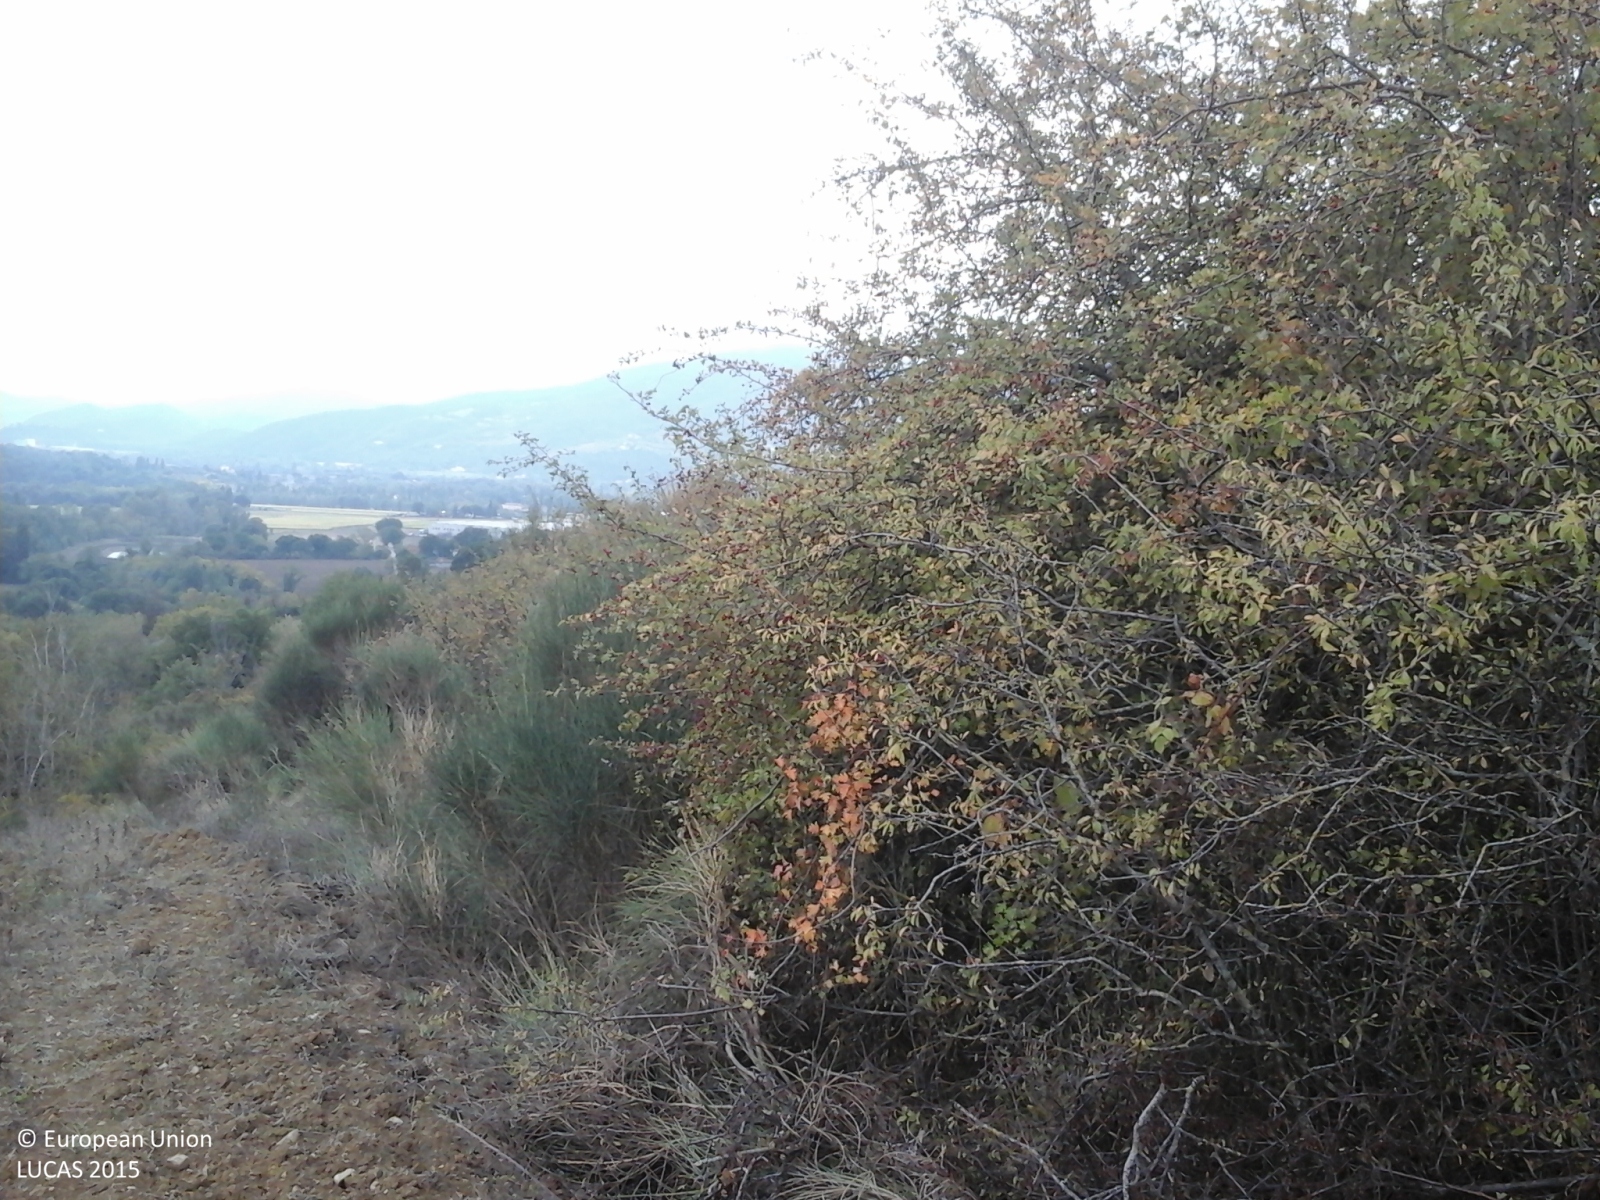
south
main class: Grassland
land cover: Spontaneously vegetated surfaces
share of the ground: 50 - 75 %
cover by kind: herbaceous plants 50 %, consolidated bare surface 35 %, unconsolidated bare surface 15 %
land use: Fallow land
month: October
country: IT
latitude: 43.3126
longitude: 12.3730
